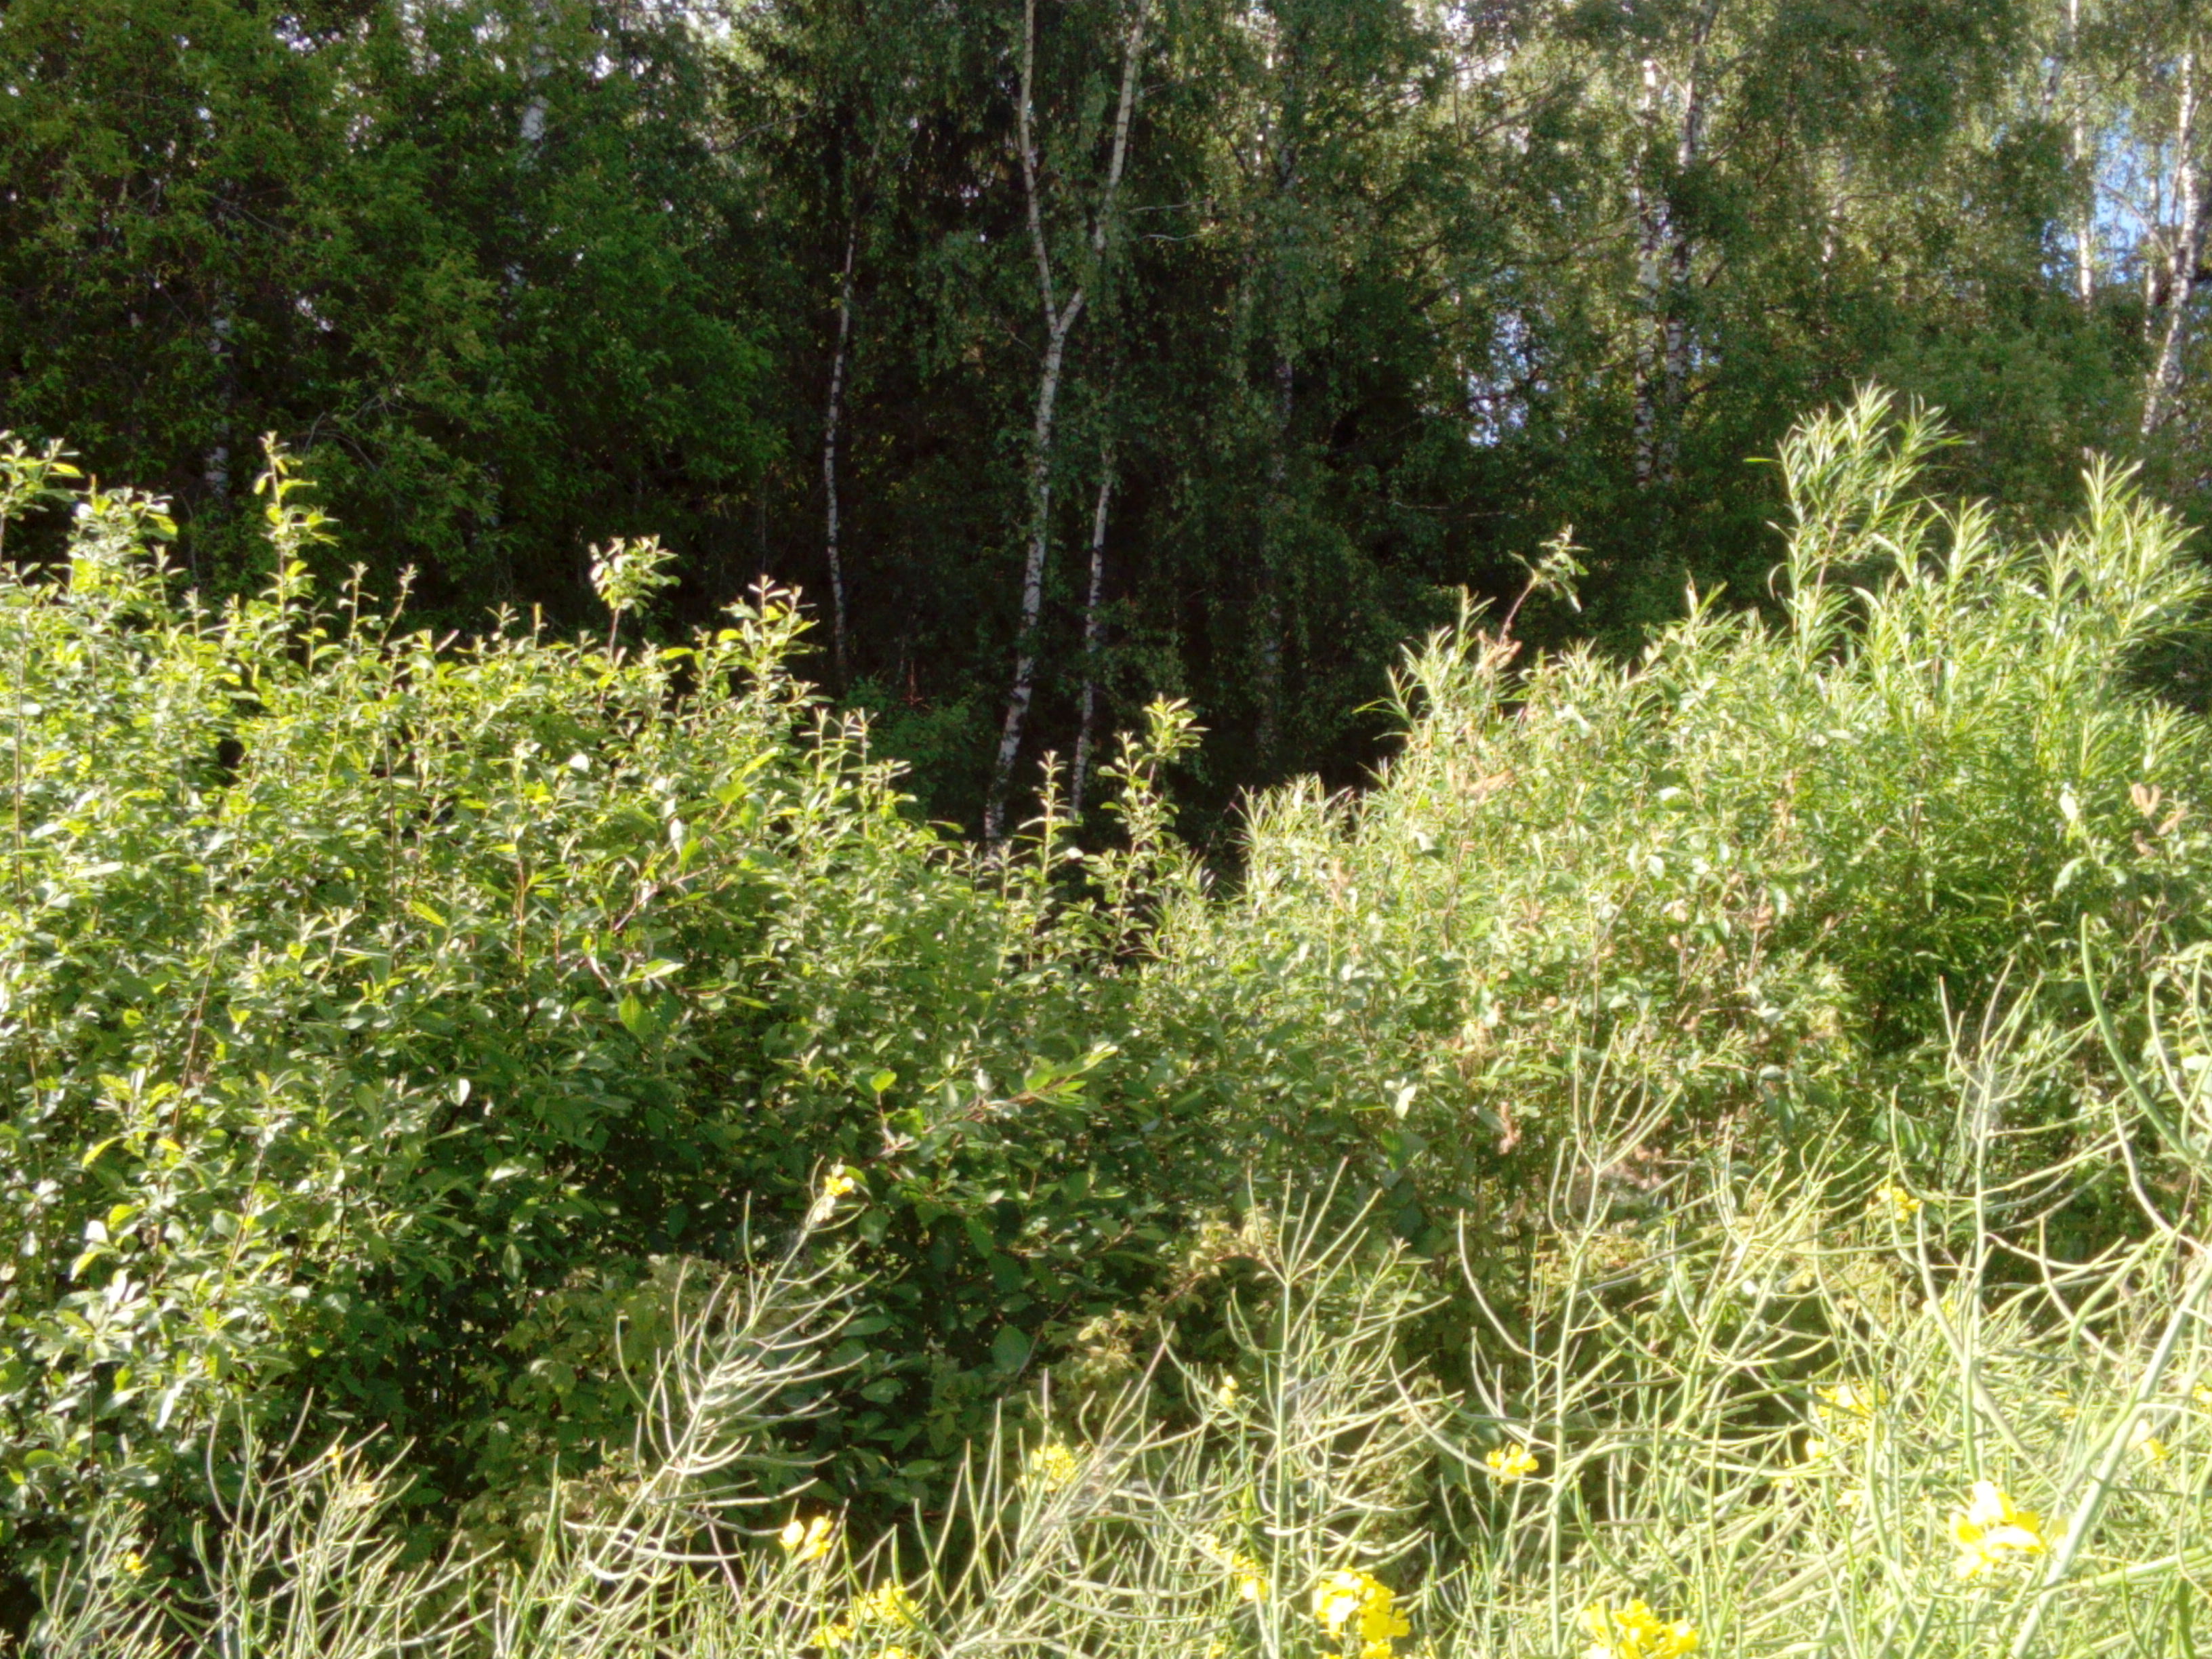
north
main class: Cropland
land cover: Rape and turnip rape
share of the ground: > 75 %
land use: Agriculture (excluding fallow land and kitchen gardens)
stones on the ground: < 10 %
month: June
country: LV
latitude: 56.6940
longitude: 22.2169
